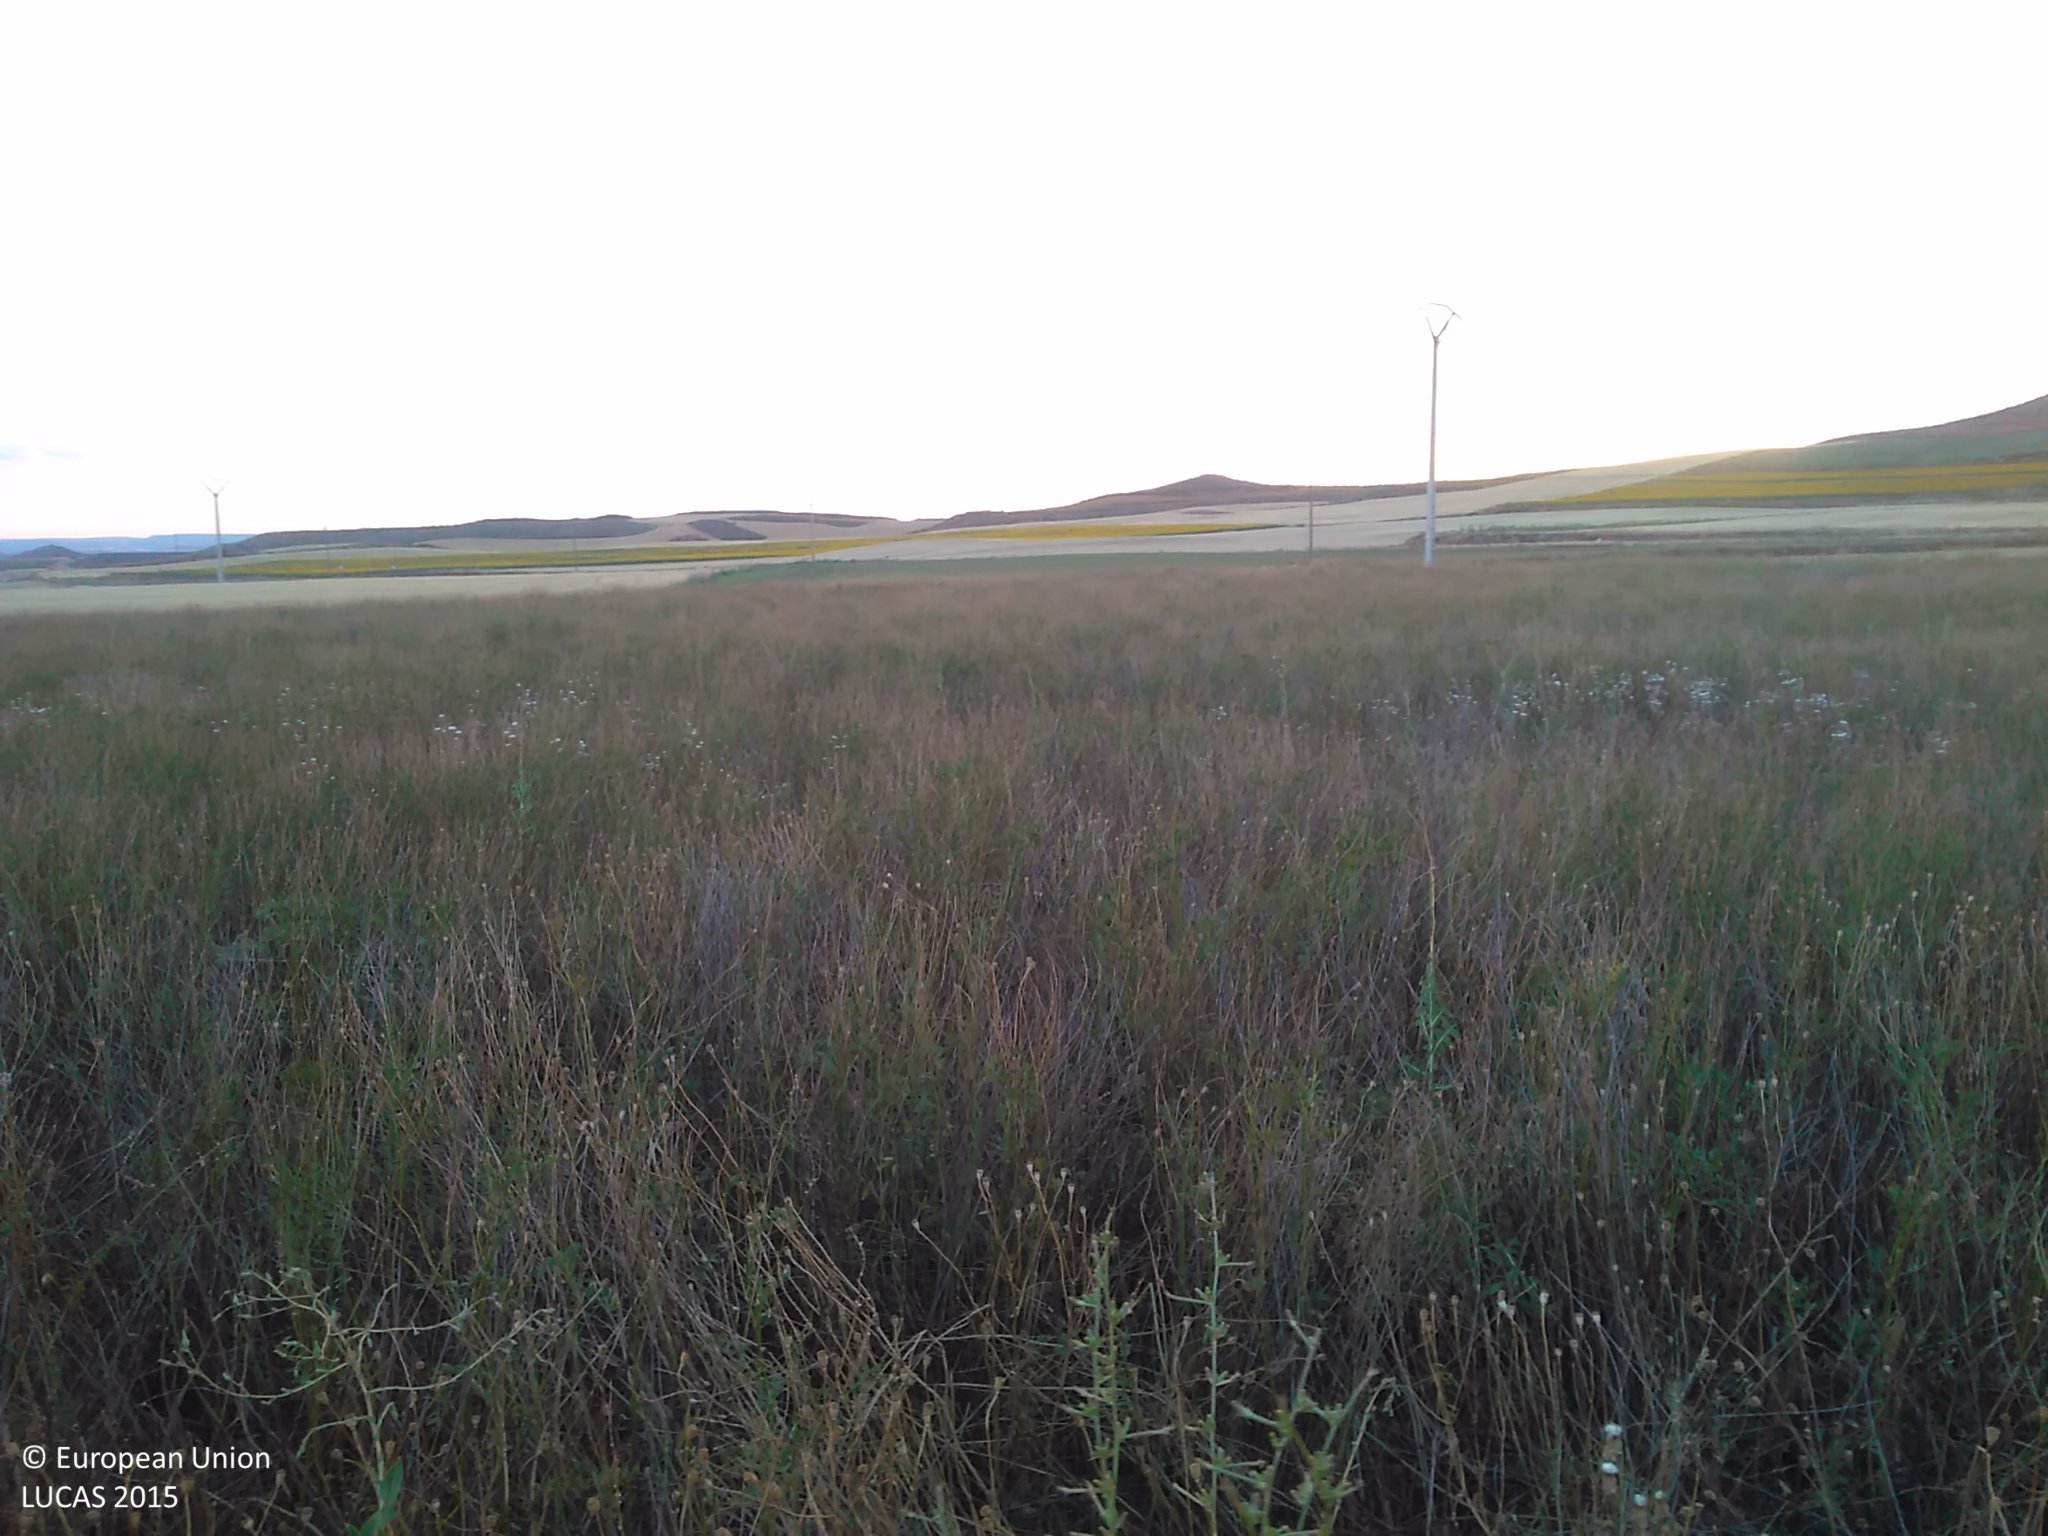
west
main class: Grassland
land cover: Spontaneously vegetated surfaces
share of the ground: > 75 %
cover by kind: herbaceous plants 85 %, unconsolidated bare surface 15 %
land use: Abandoned areas
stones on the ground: < 10 %
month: July
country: ES
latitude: 41.4416
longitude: -2.1797
